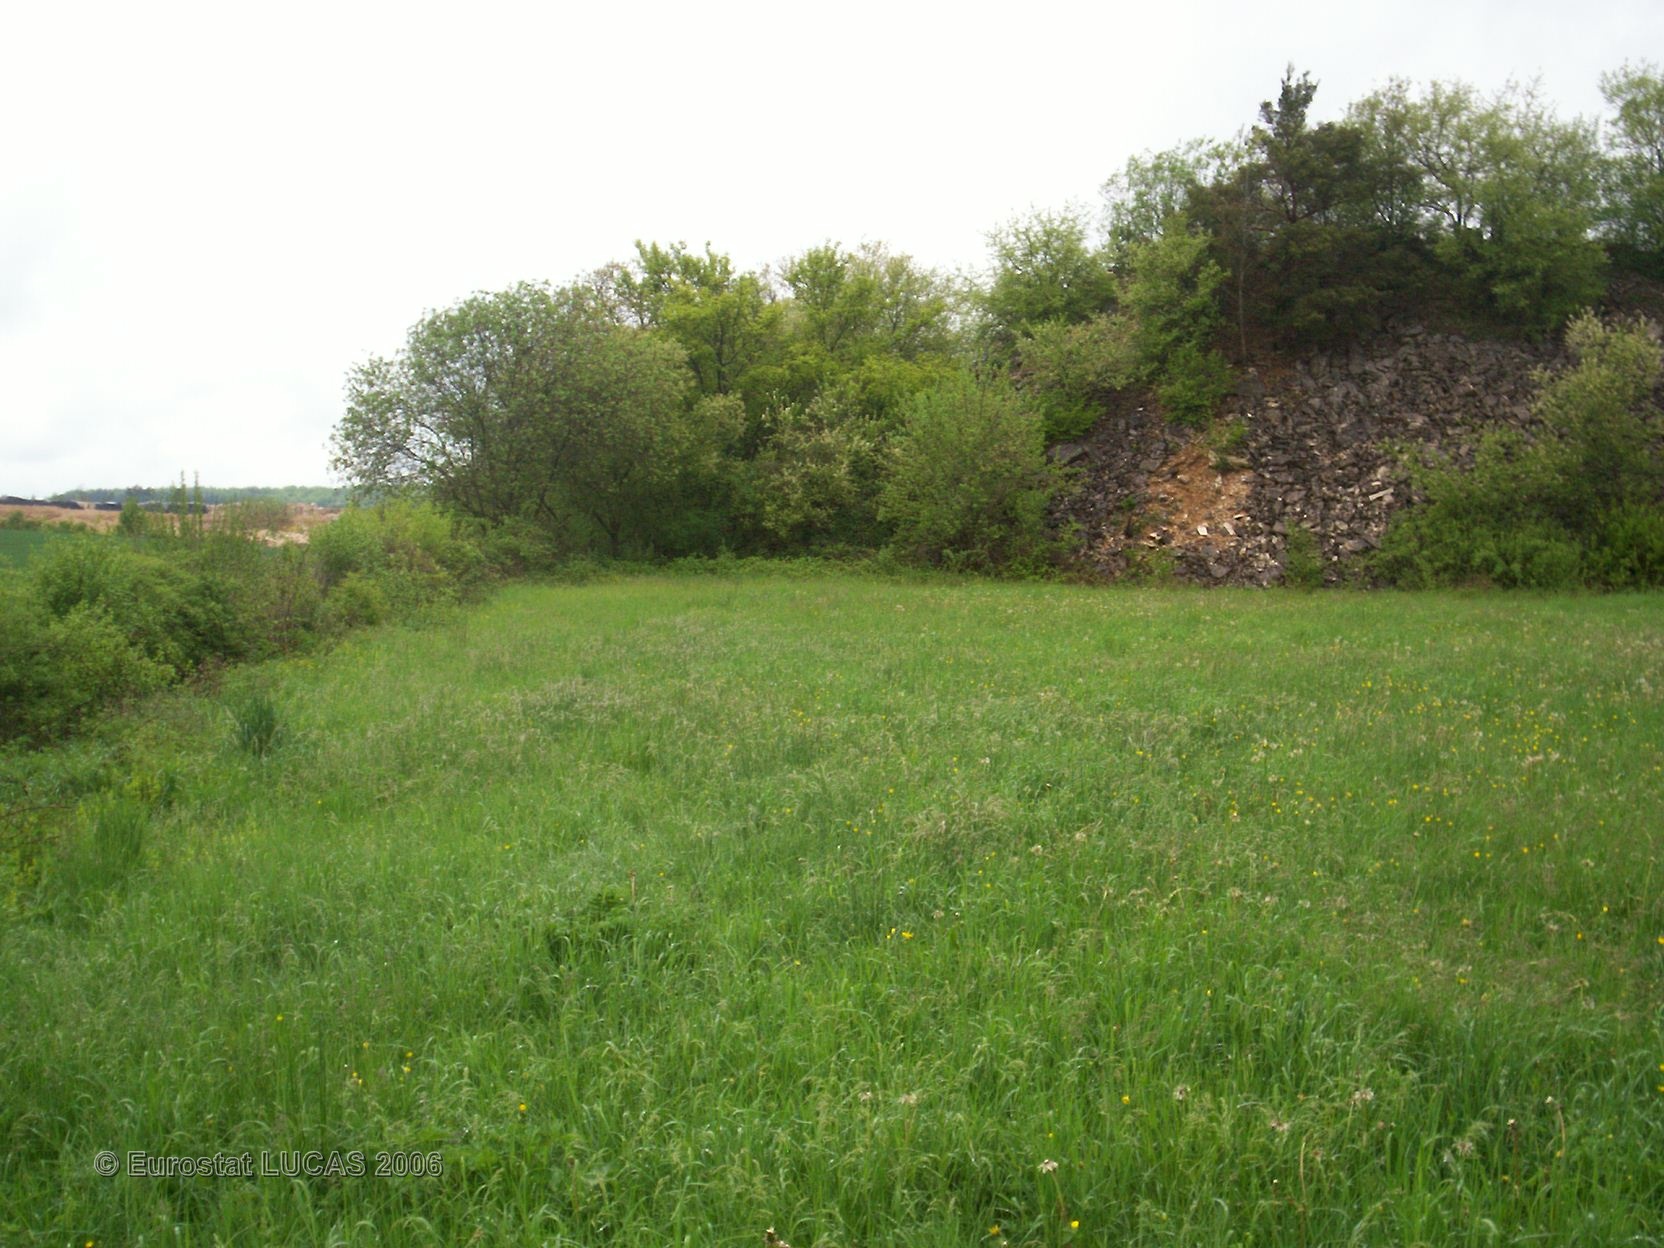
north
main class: Grassland
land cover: Grassland without tree/shrub cover
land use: Agriculture (excluding fallow land and kitchen gardens)
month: May
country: FR
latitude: 47.7816
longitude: 4.5399
